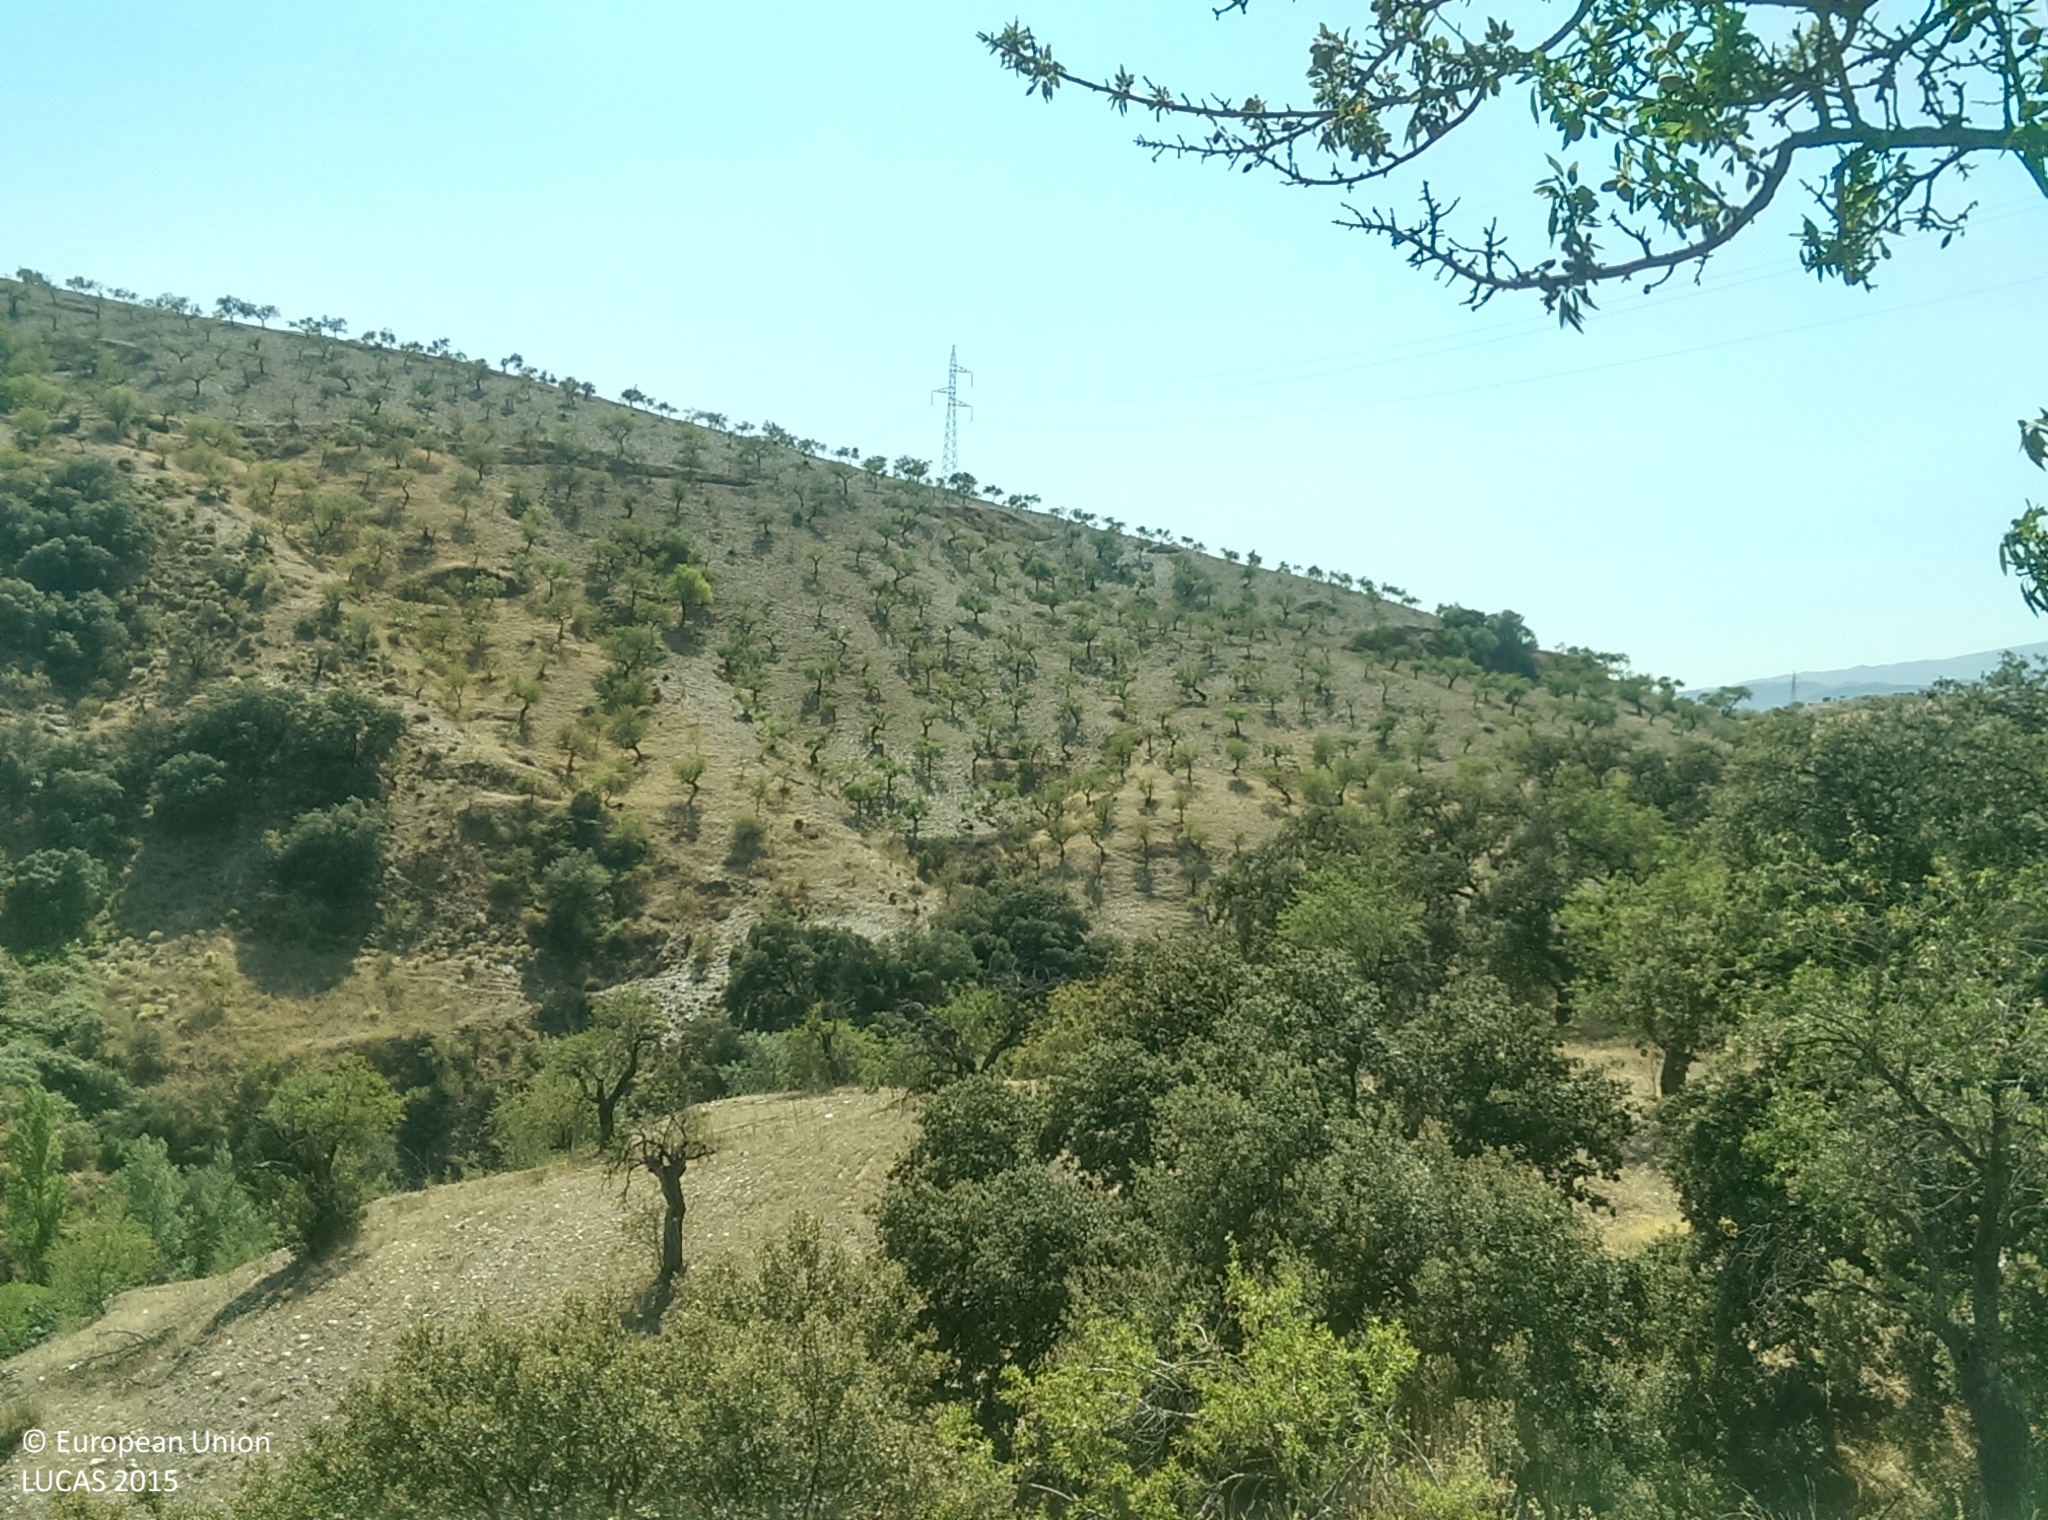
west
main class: Cropland
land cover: Nuts trees
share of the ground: 25 - 50 %
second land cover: Spontaneously vegetated surfaces
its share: 50 - 75 %
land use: Agriculture (excluding fallow land and kitchen gardens)
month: July
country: ES
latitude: 36.9220
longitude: -3.1488
